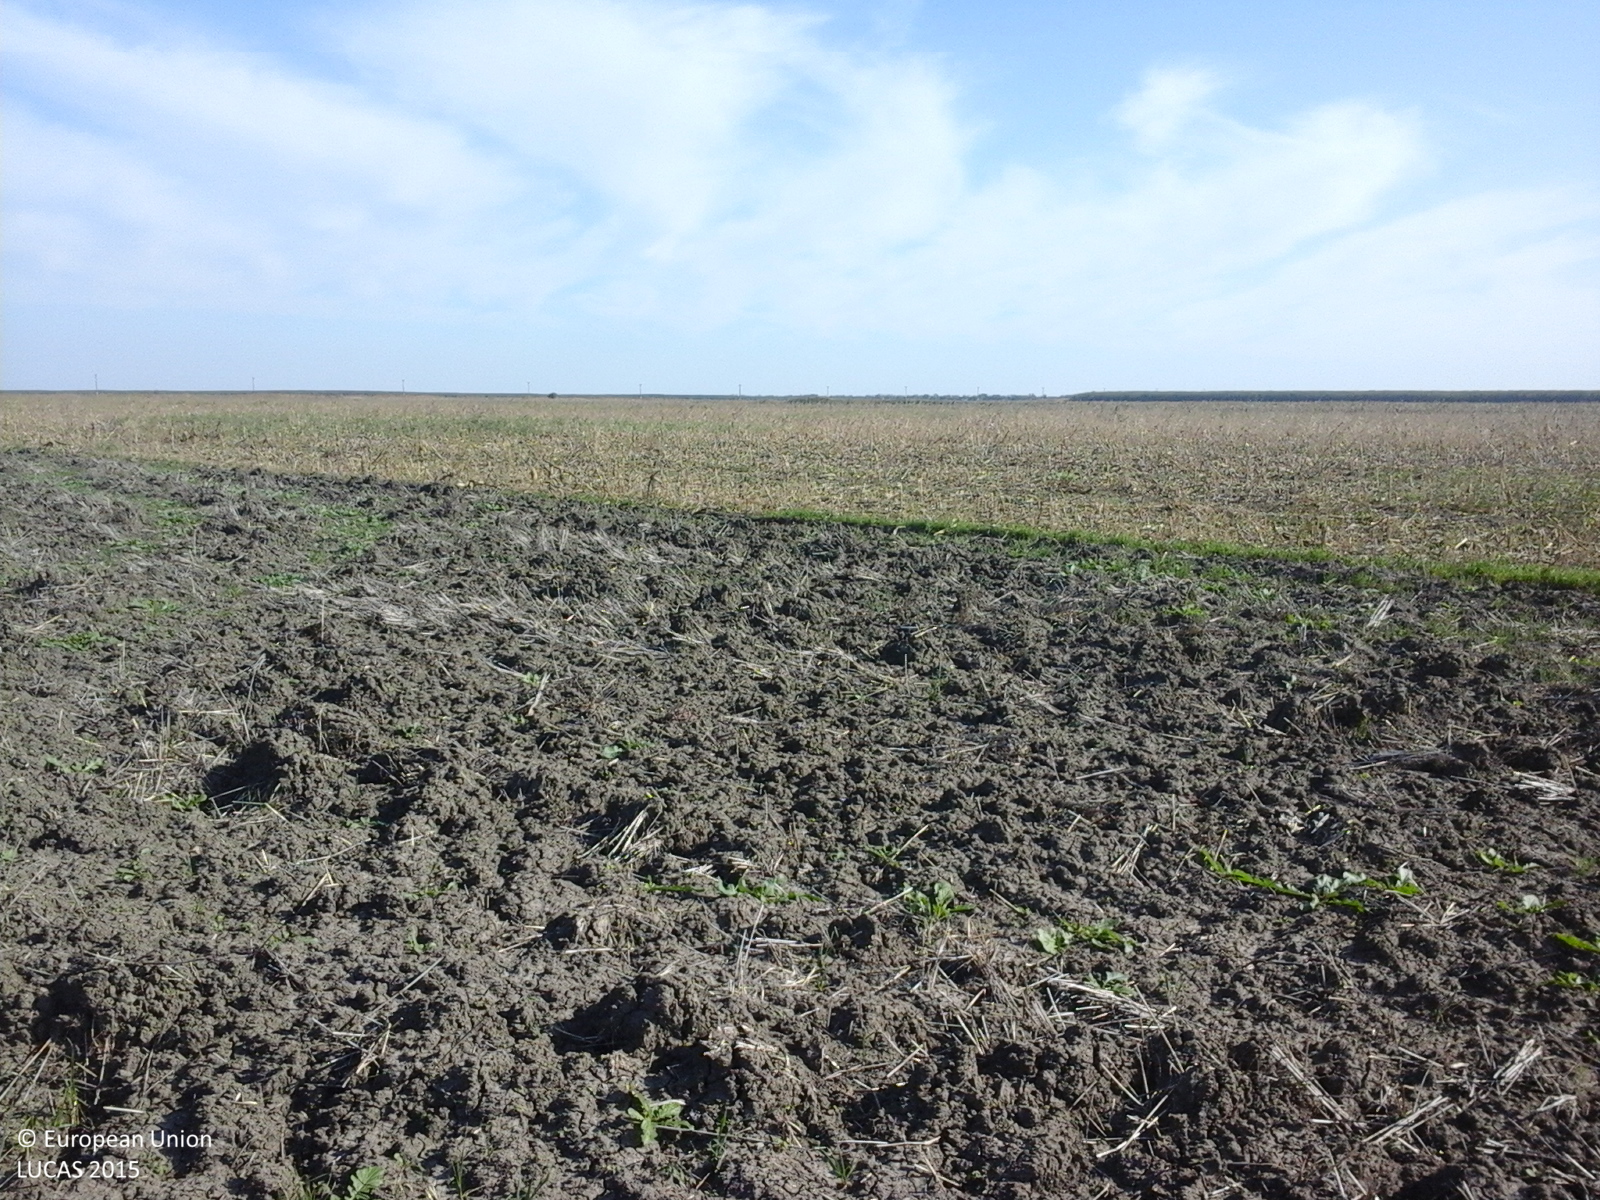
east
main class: Cropland
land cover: Durum wheat
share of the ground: > 75 %
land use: Agriculture (excluding fallow land and kitchen gardens)
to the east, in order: Durum wheat; Maize
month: October
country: RO
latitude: 45.4410
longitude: 27.4222
